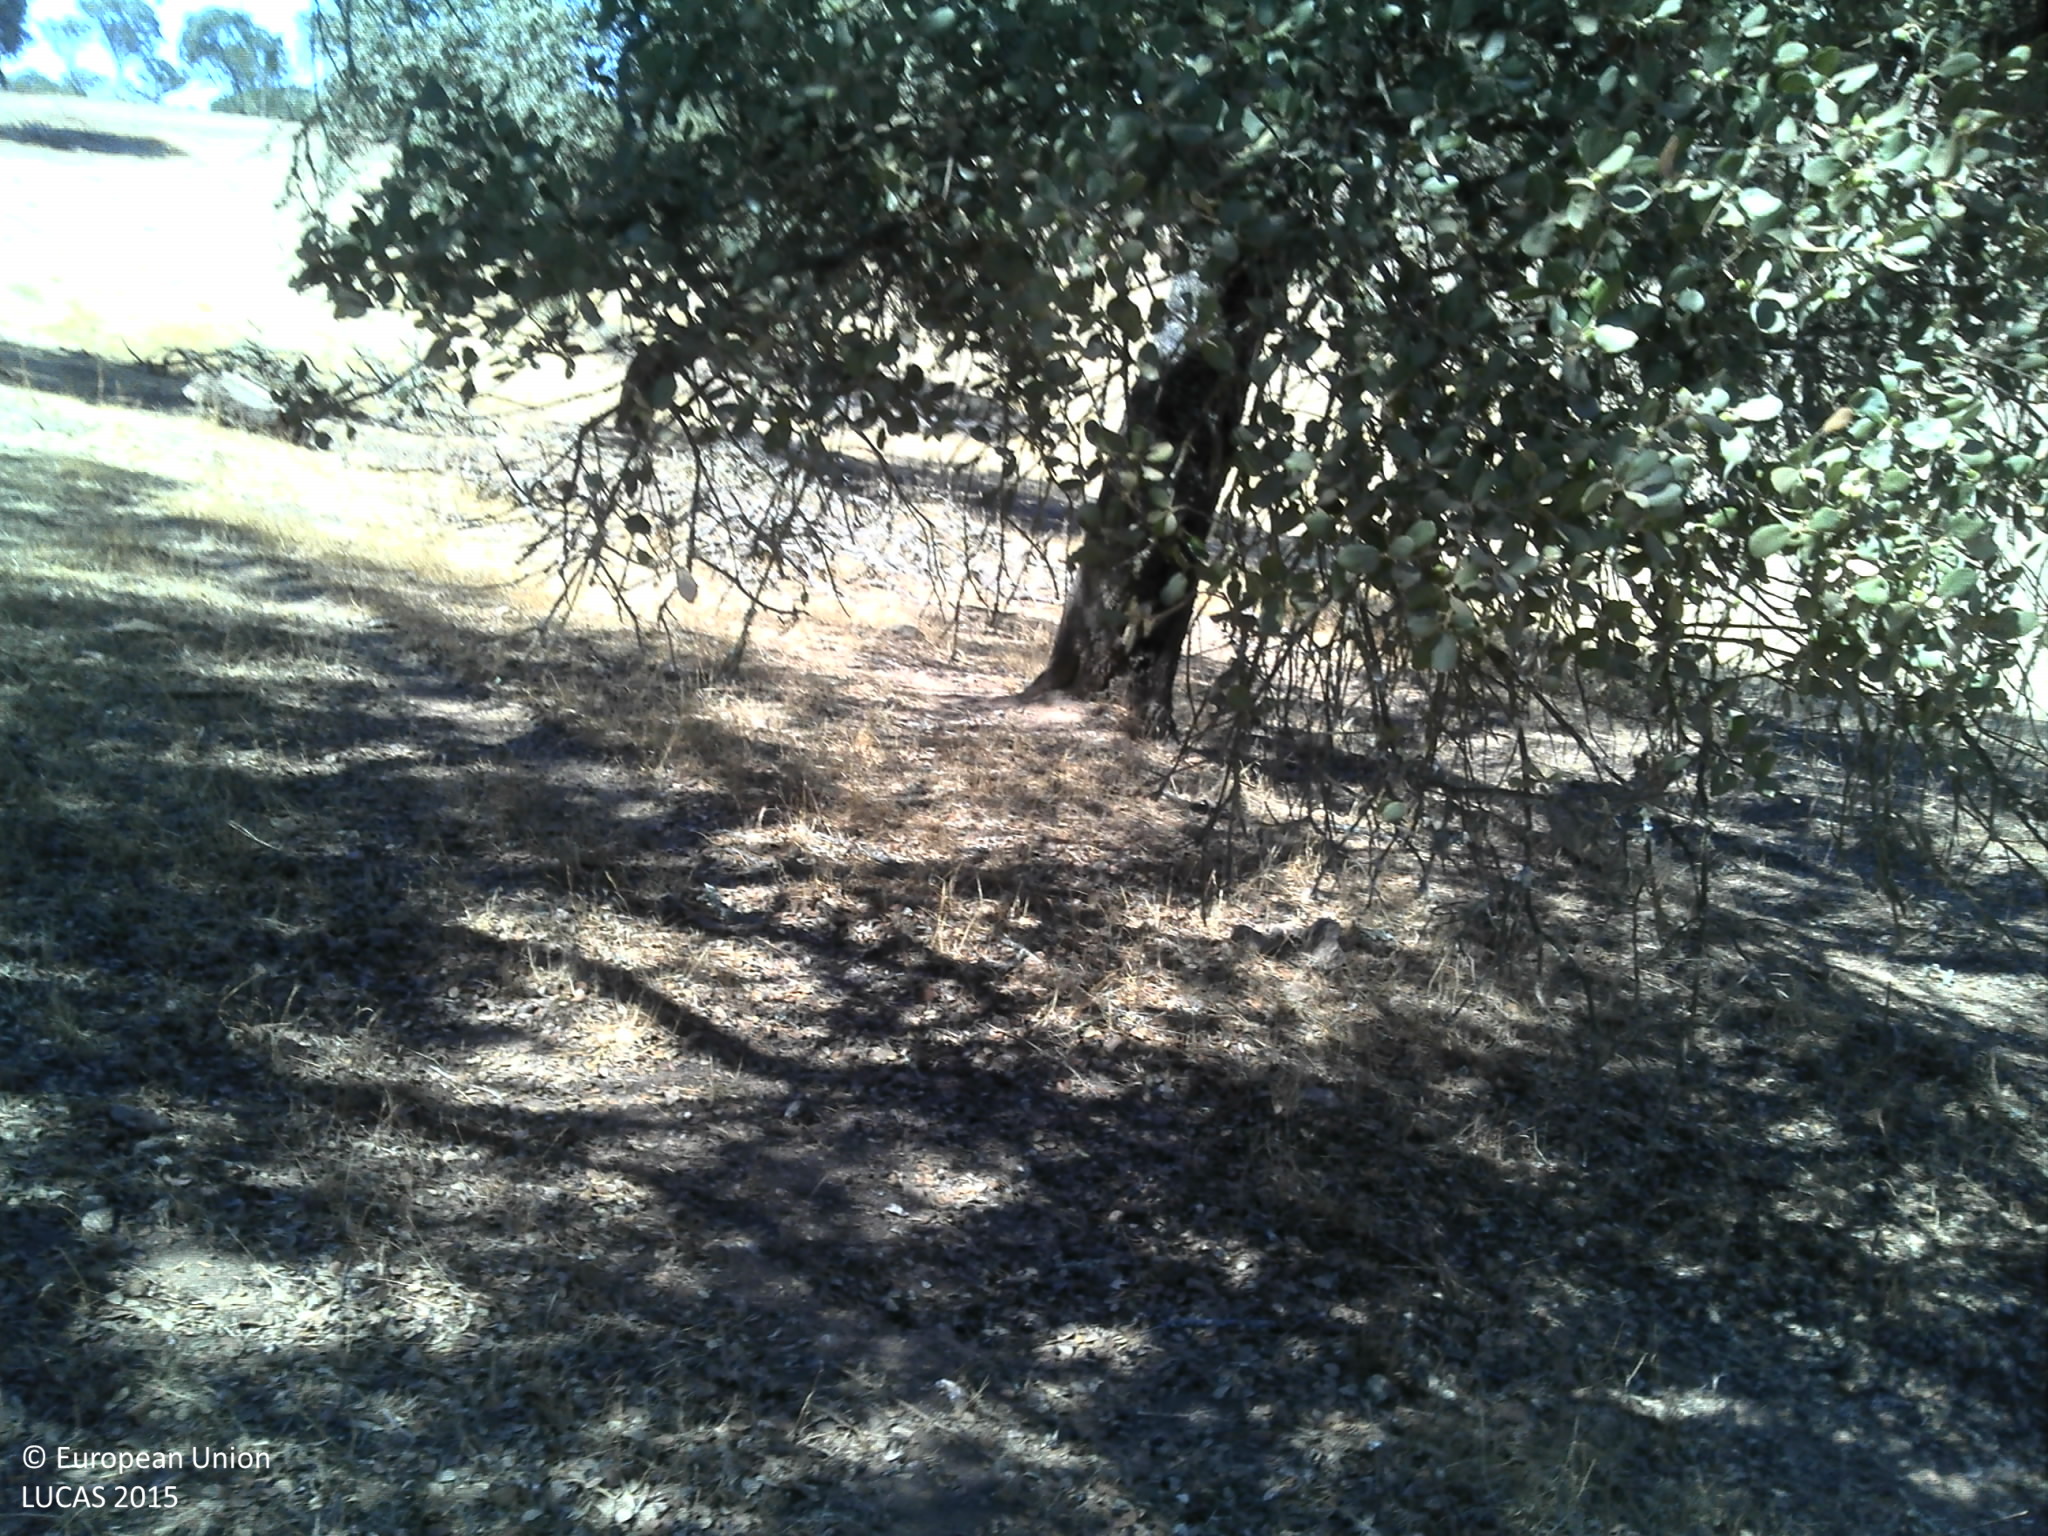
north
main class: Woodland
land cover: Broadleaved woodland
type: broadleaved evergreen forest
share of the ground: > 75 %
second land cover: Grassland without tree/shrub cover
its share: < 10 %
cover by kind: broadleaved forest trees 95 %, herbaceous plants 5 %
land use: Agriculture (excluding fallow land and kitchen gardens)
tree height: > 5 m
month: July
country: PT
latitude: 38.0022
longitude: -8.0598
